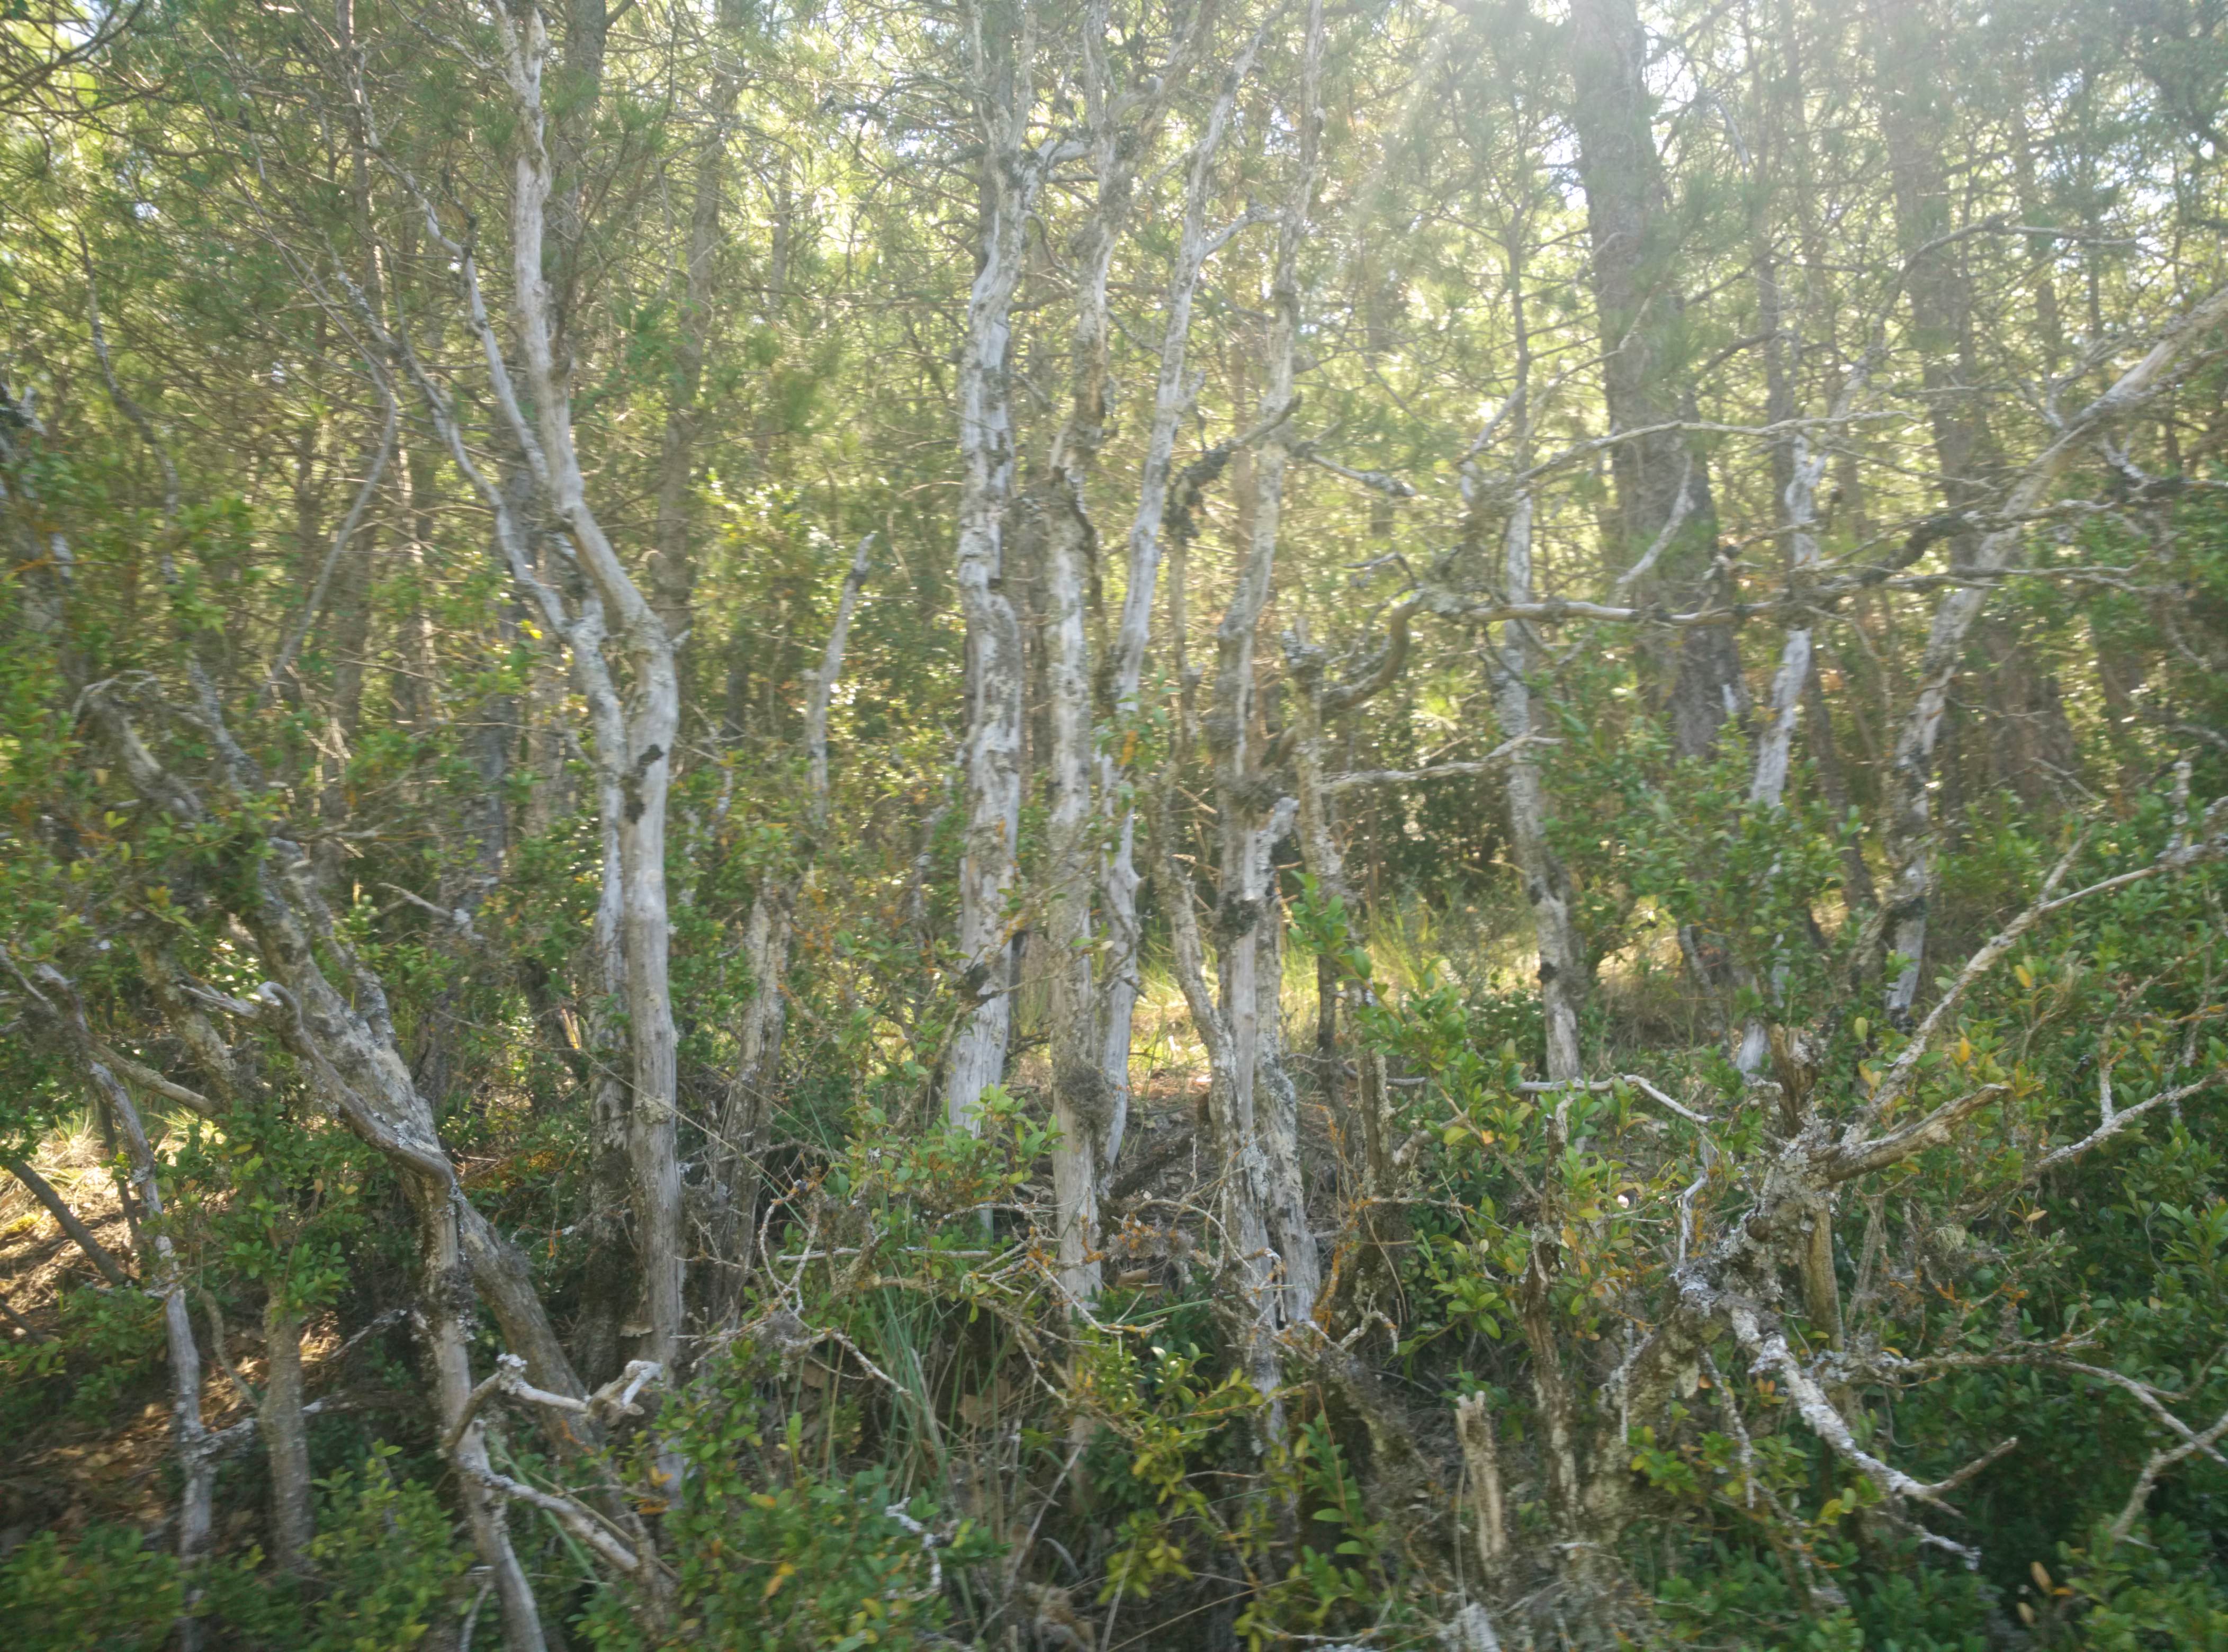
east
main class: Woodland
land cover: Pine dominated mixed woodland
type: coniferous forest of the mediterranean region
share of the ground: 50 - 75 %
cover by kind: coniferous forest trees 40 %, unconsolidated bare surface 25 %, broadleaved forest trees 20 %, shrubs 10 %, herbaceous plants 5 %
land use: Semi-natural and natural areas not in use
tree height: > 5 m
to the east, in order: Pine dominated mixed woodland; Rocks and stones; Pine dominated mixed woodland; Tracks; Pine dominated mixed woodland
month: June
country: ES
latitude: 40.6629
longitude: -1.9796
